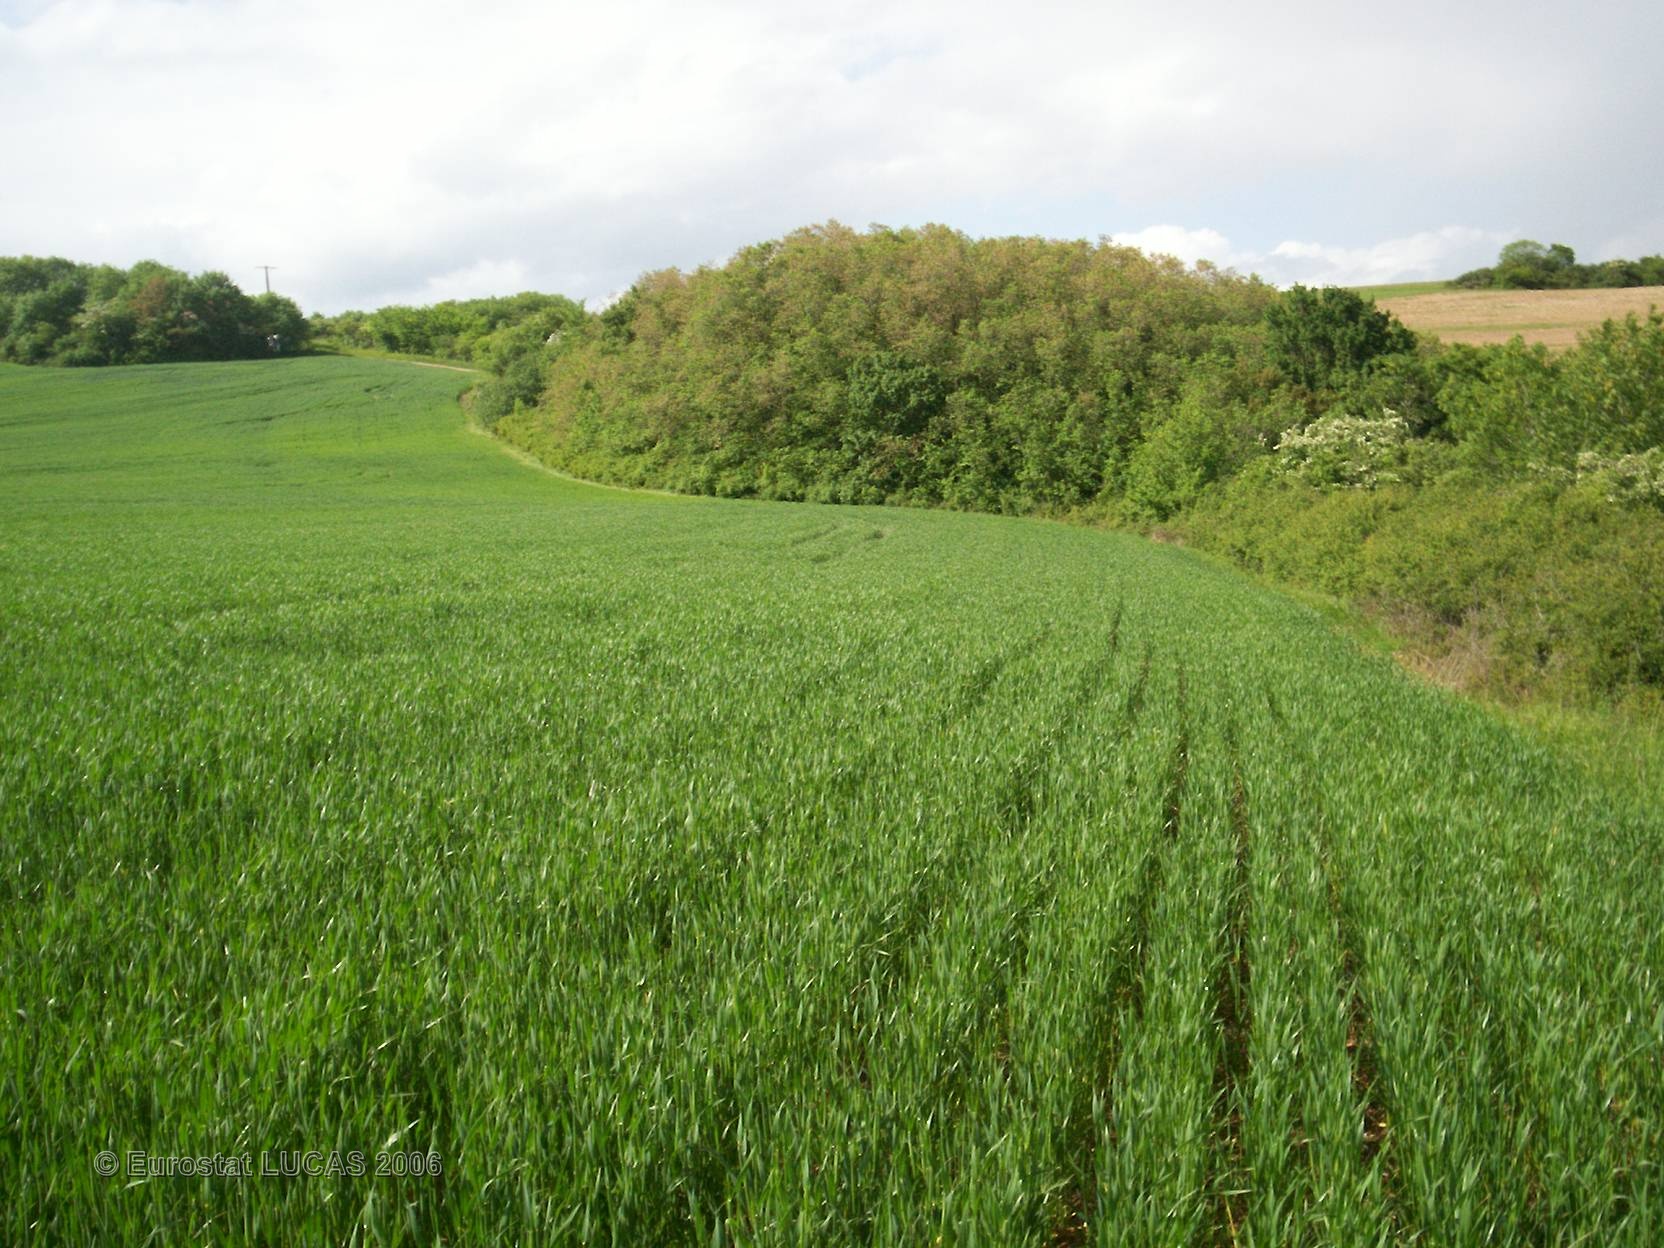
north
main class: Cropland
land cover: Common wheat
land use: Agriculture (excluding fallow land and kitchen gardens)
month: May
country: FR
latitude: 46.9766
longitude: 4.6767
